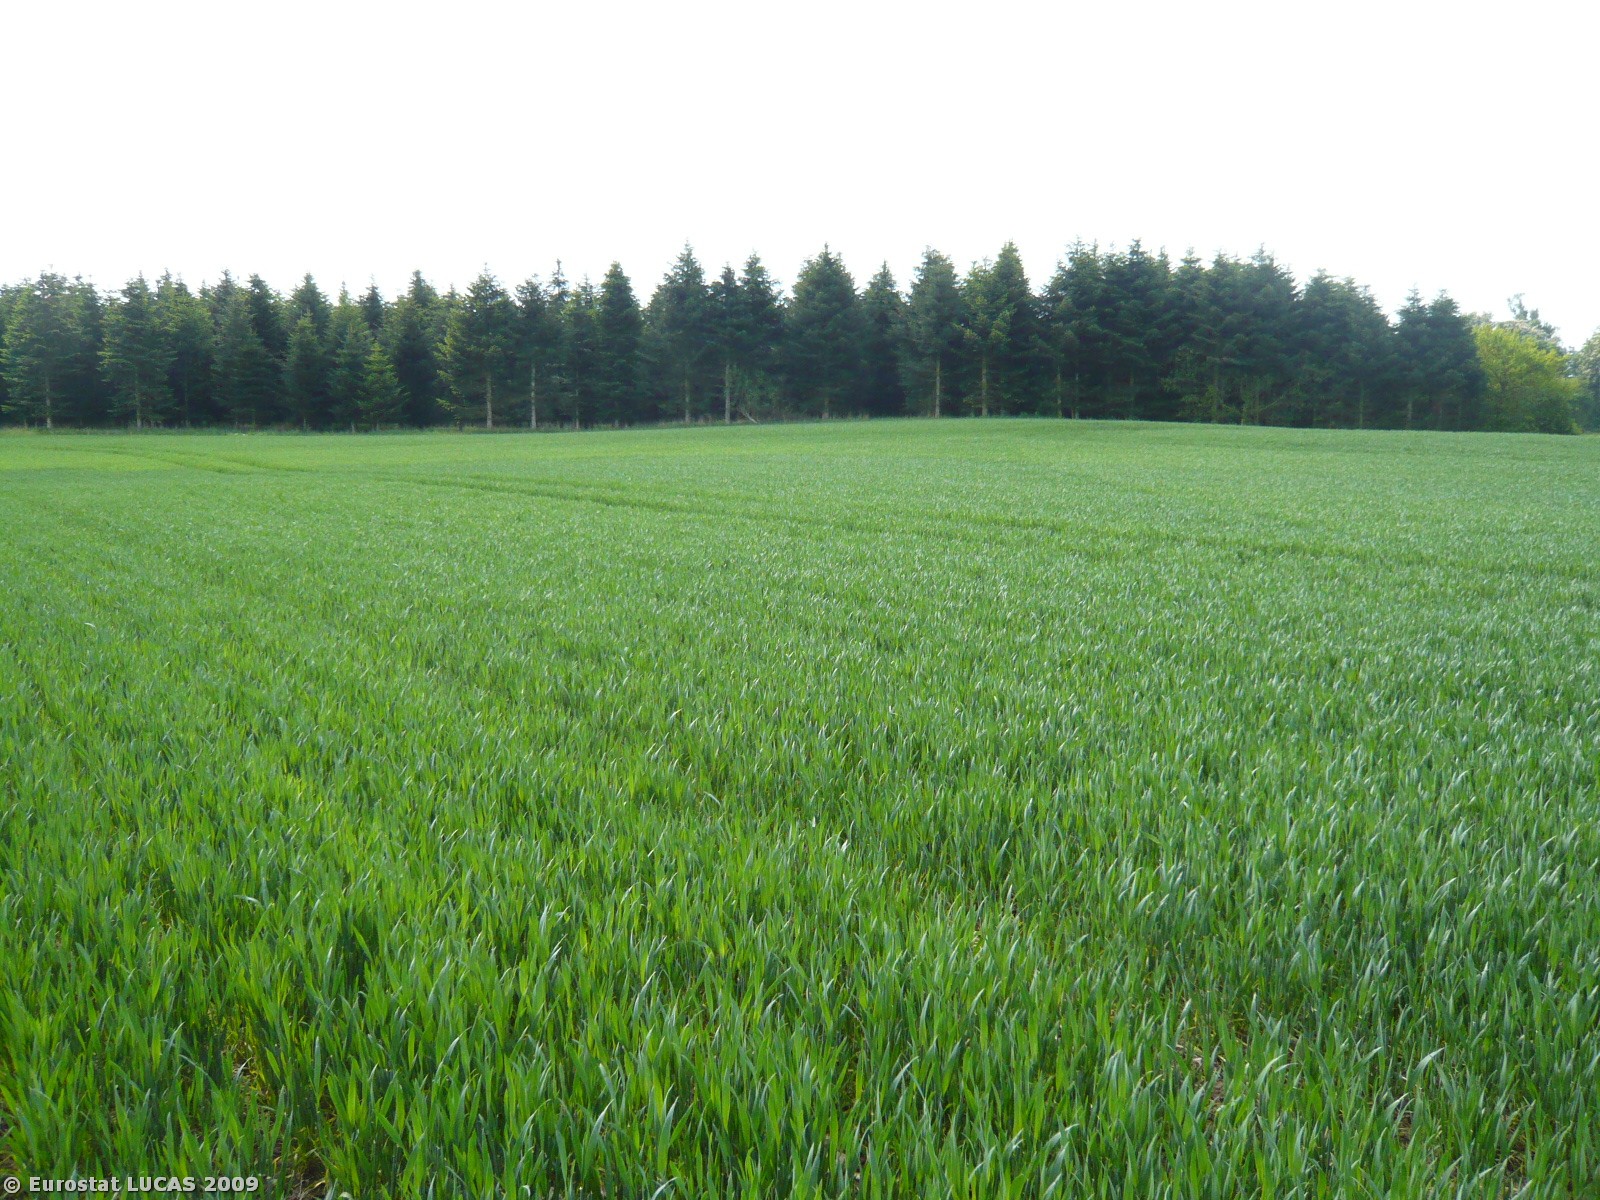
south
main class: Cropland
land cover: Common wheat
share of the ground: > 75 %
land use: Agriculture (excluding fallow land and kitchen gardens)
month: May
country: DK
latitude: 55.3271
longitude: 12.0002
